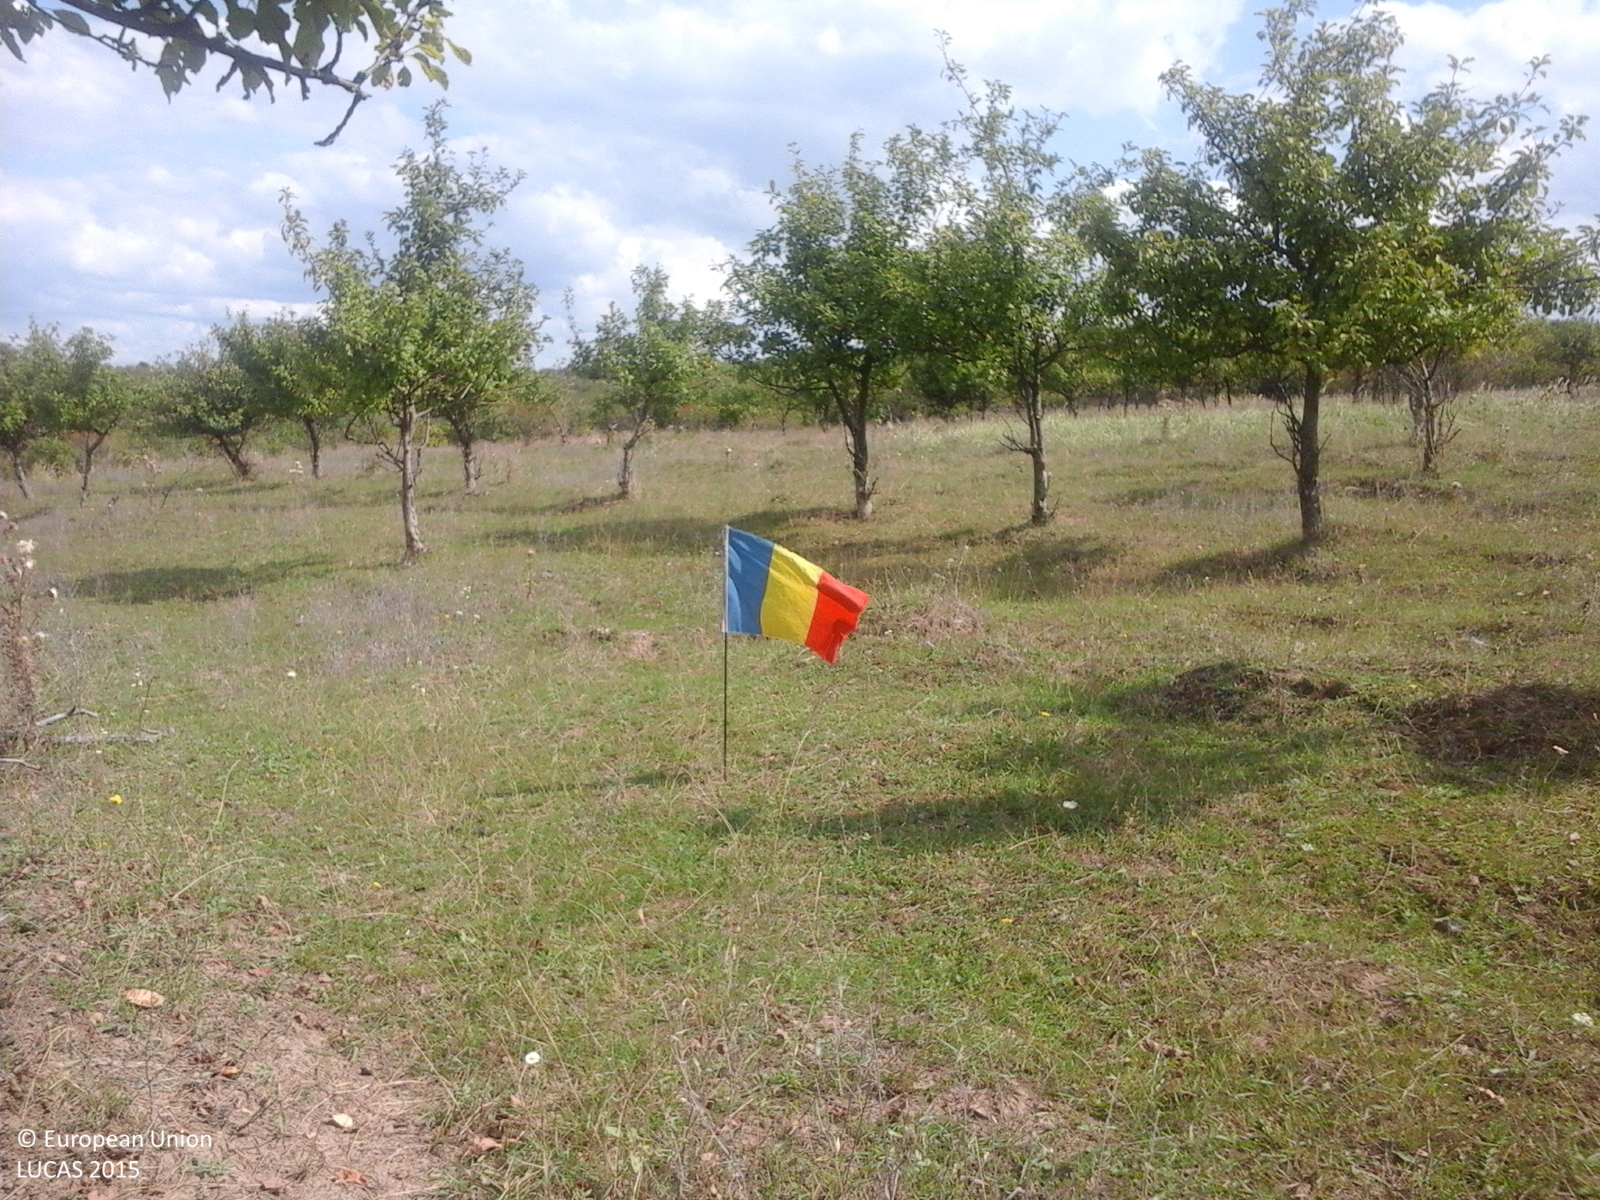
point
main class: Cropland
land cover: Apple fruit
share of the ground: > 75 %
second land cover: Grassland without tree/shrub cover
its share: > 75 %
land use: Agriculture (excluding fallow land and kitchen gardens)
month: September
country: RO
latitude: 47.2859
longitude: 22.8467
